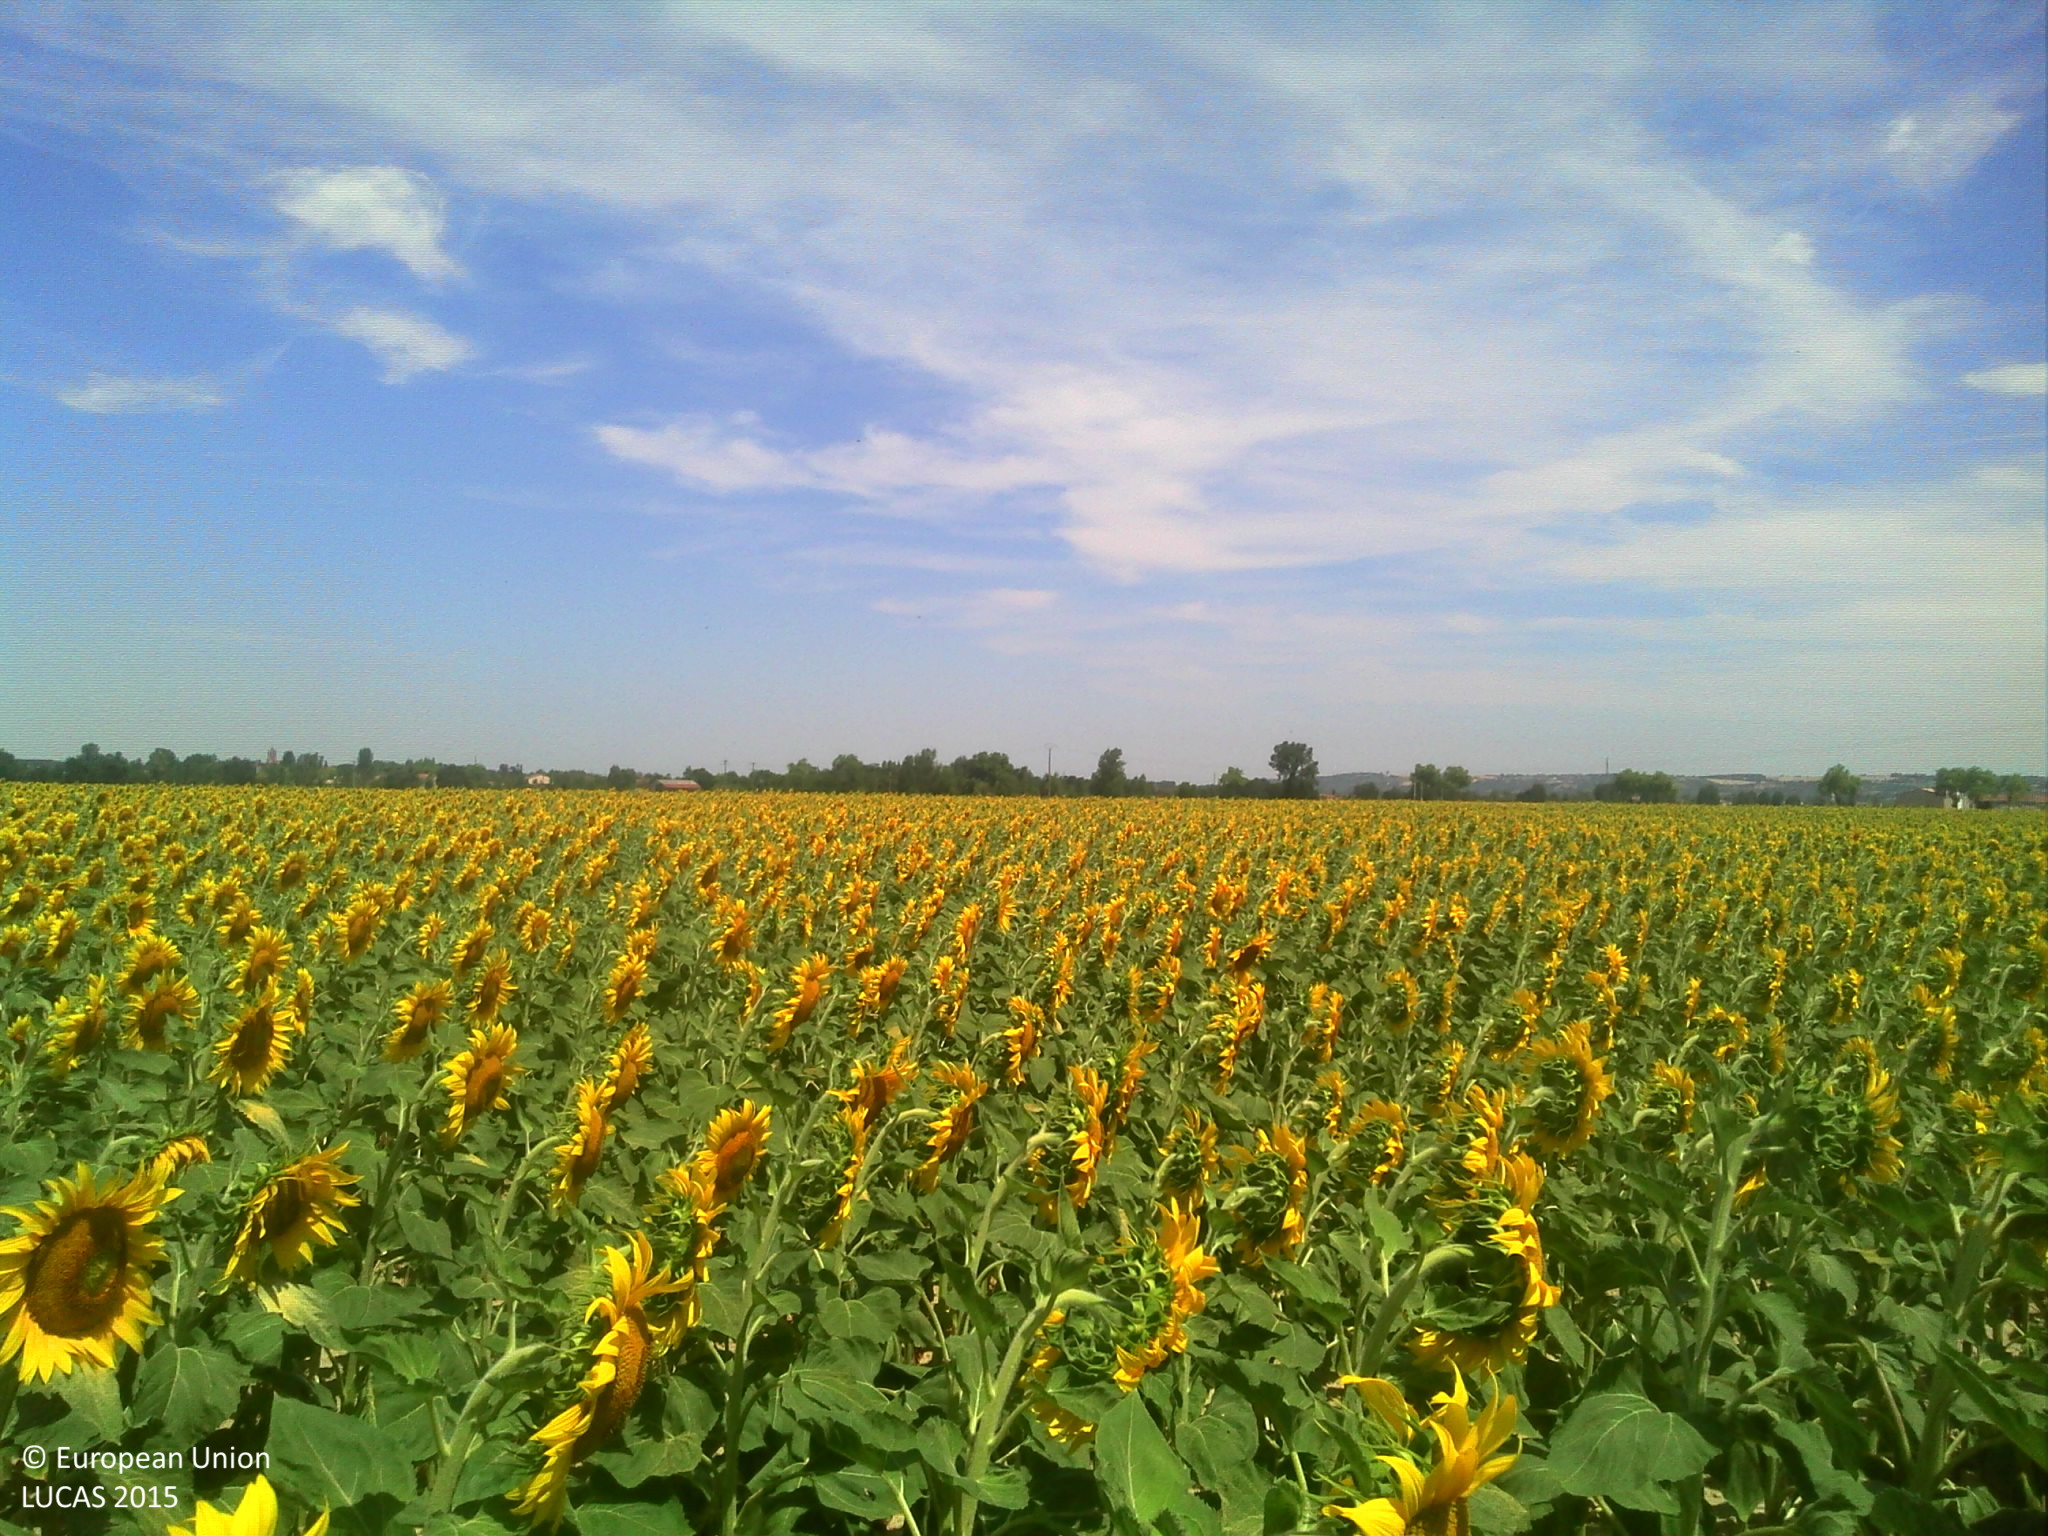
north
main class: Cropland
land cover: Sunflower
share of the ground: > 75 %
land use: Agriculture (excluding fallow land and kitchen gardens)
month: July
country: FR
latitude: 43.3944
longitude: 1.3984
